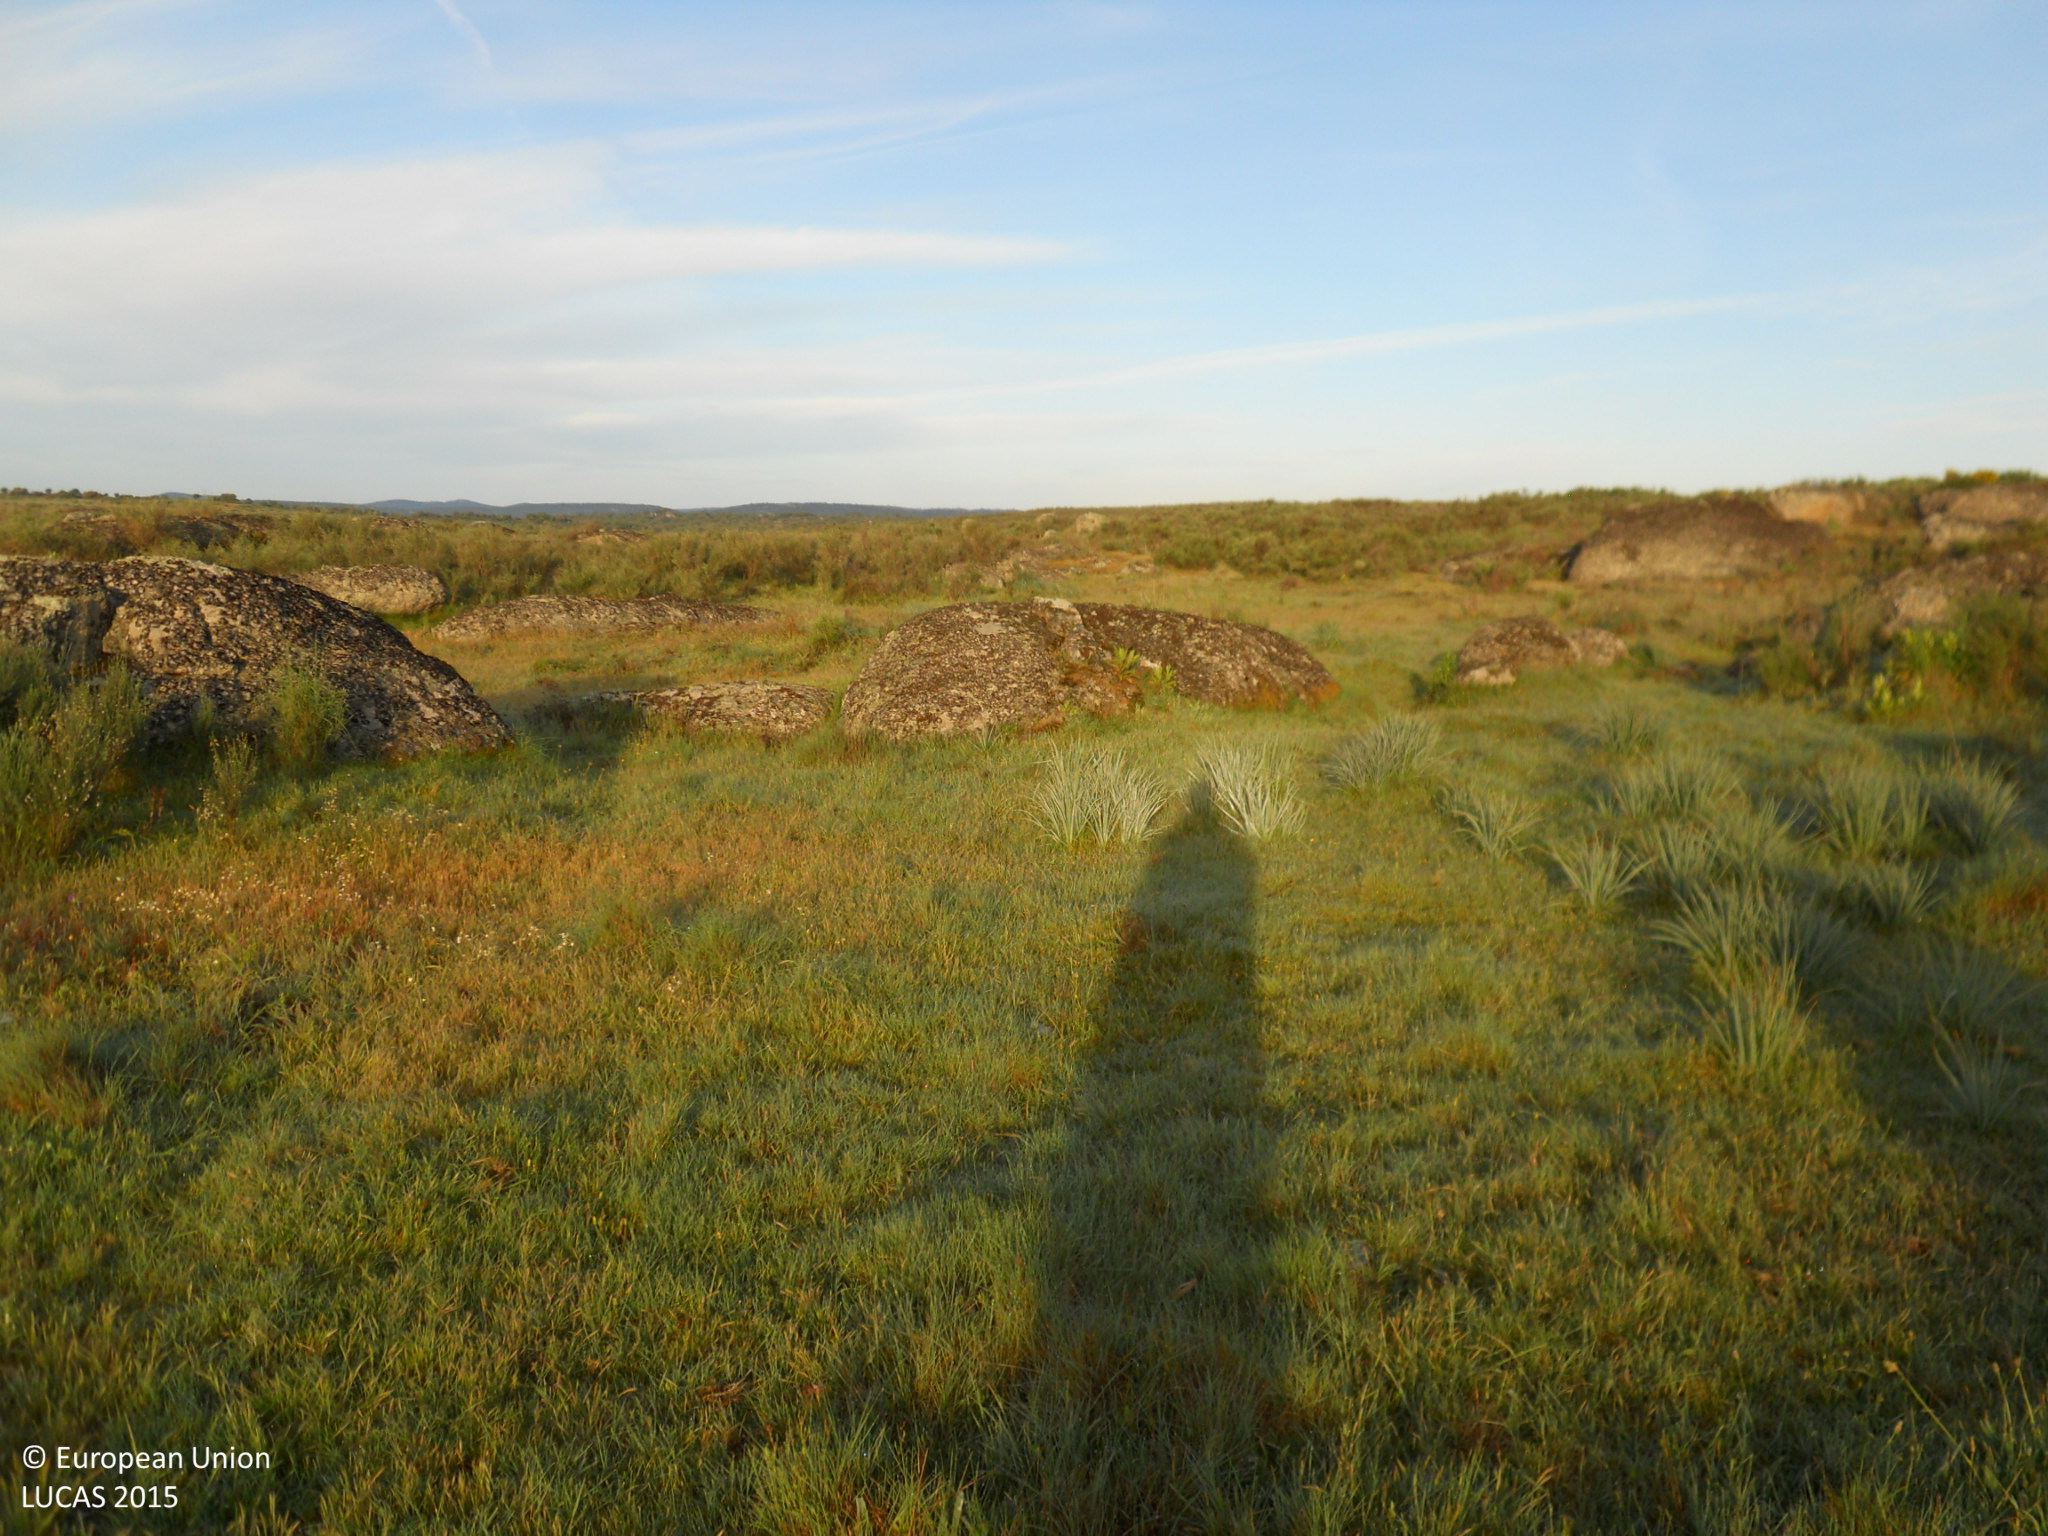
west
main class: Grassland
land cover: Grassland with sparse tree/shrub cover
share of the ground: > 75 %
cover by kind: herbaceous plants 90 %, broadleaved forest trees 5 %, shrubs 5 %
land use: Agriculture (excluding fallow land and kitchen gardens)
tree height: < 5 m
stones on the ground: 10 - 25 %
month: April
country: ES
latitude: 39.2769
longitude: -7.0614
